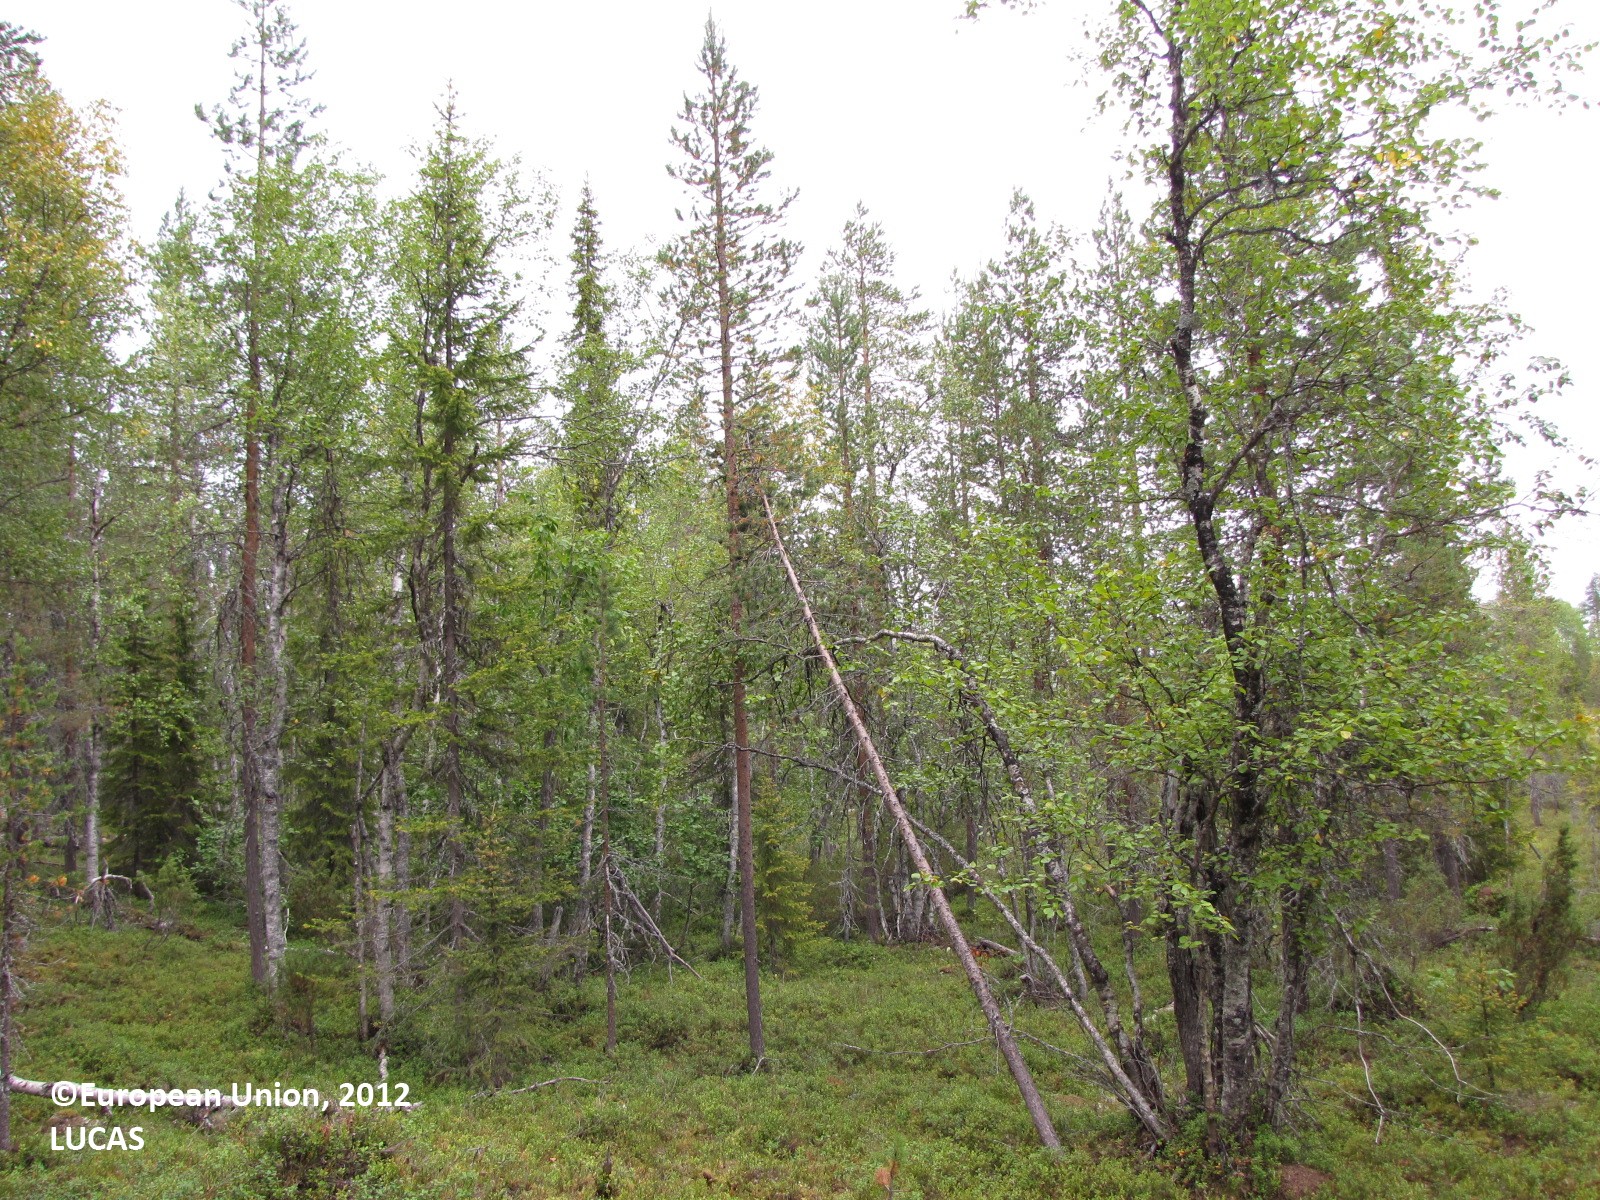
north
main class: Woodland
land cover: Pine dominated mixed woodland
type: boreal forest
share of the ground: 50 - 75 %
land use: Forestry
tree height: > 5 m
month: August
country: FI
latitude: 67.1262
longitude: 25.3363
